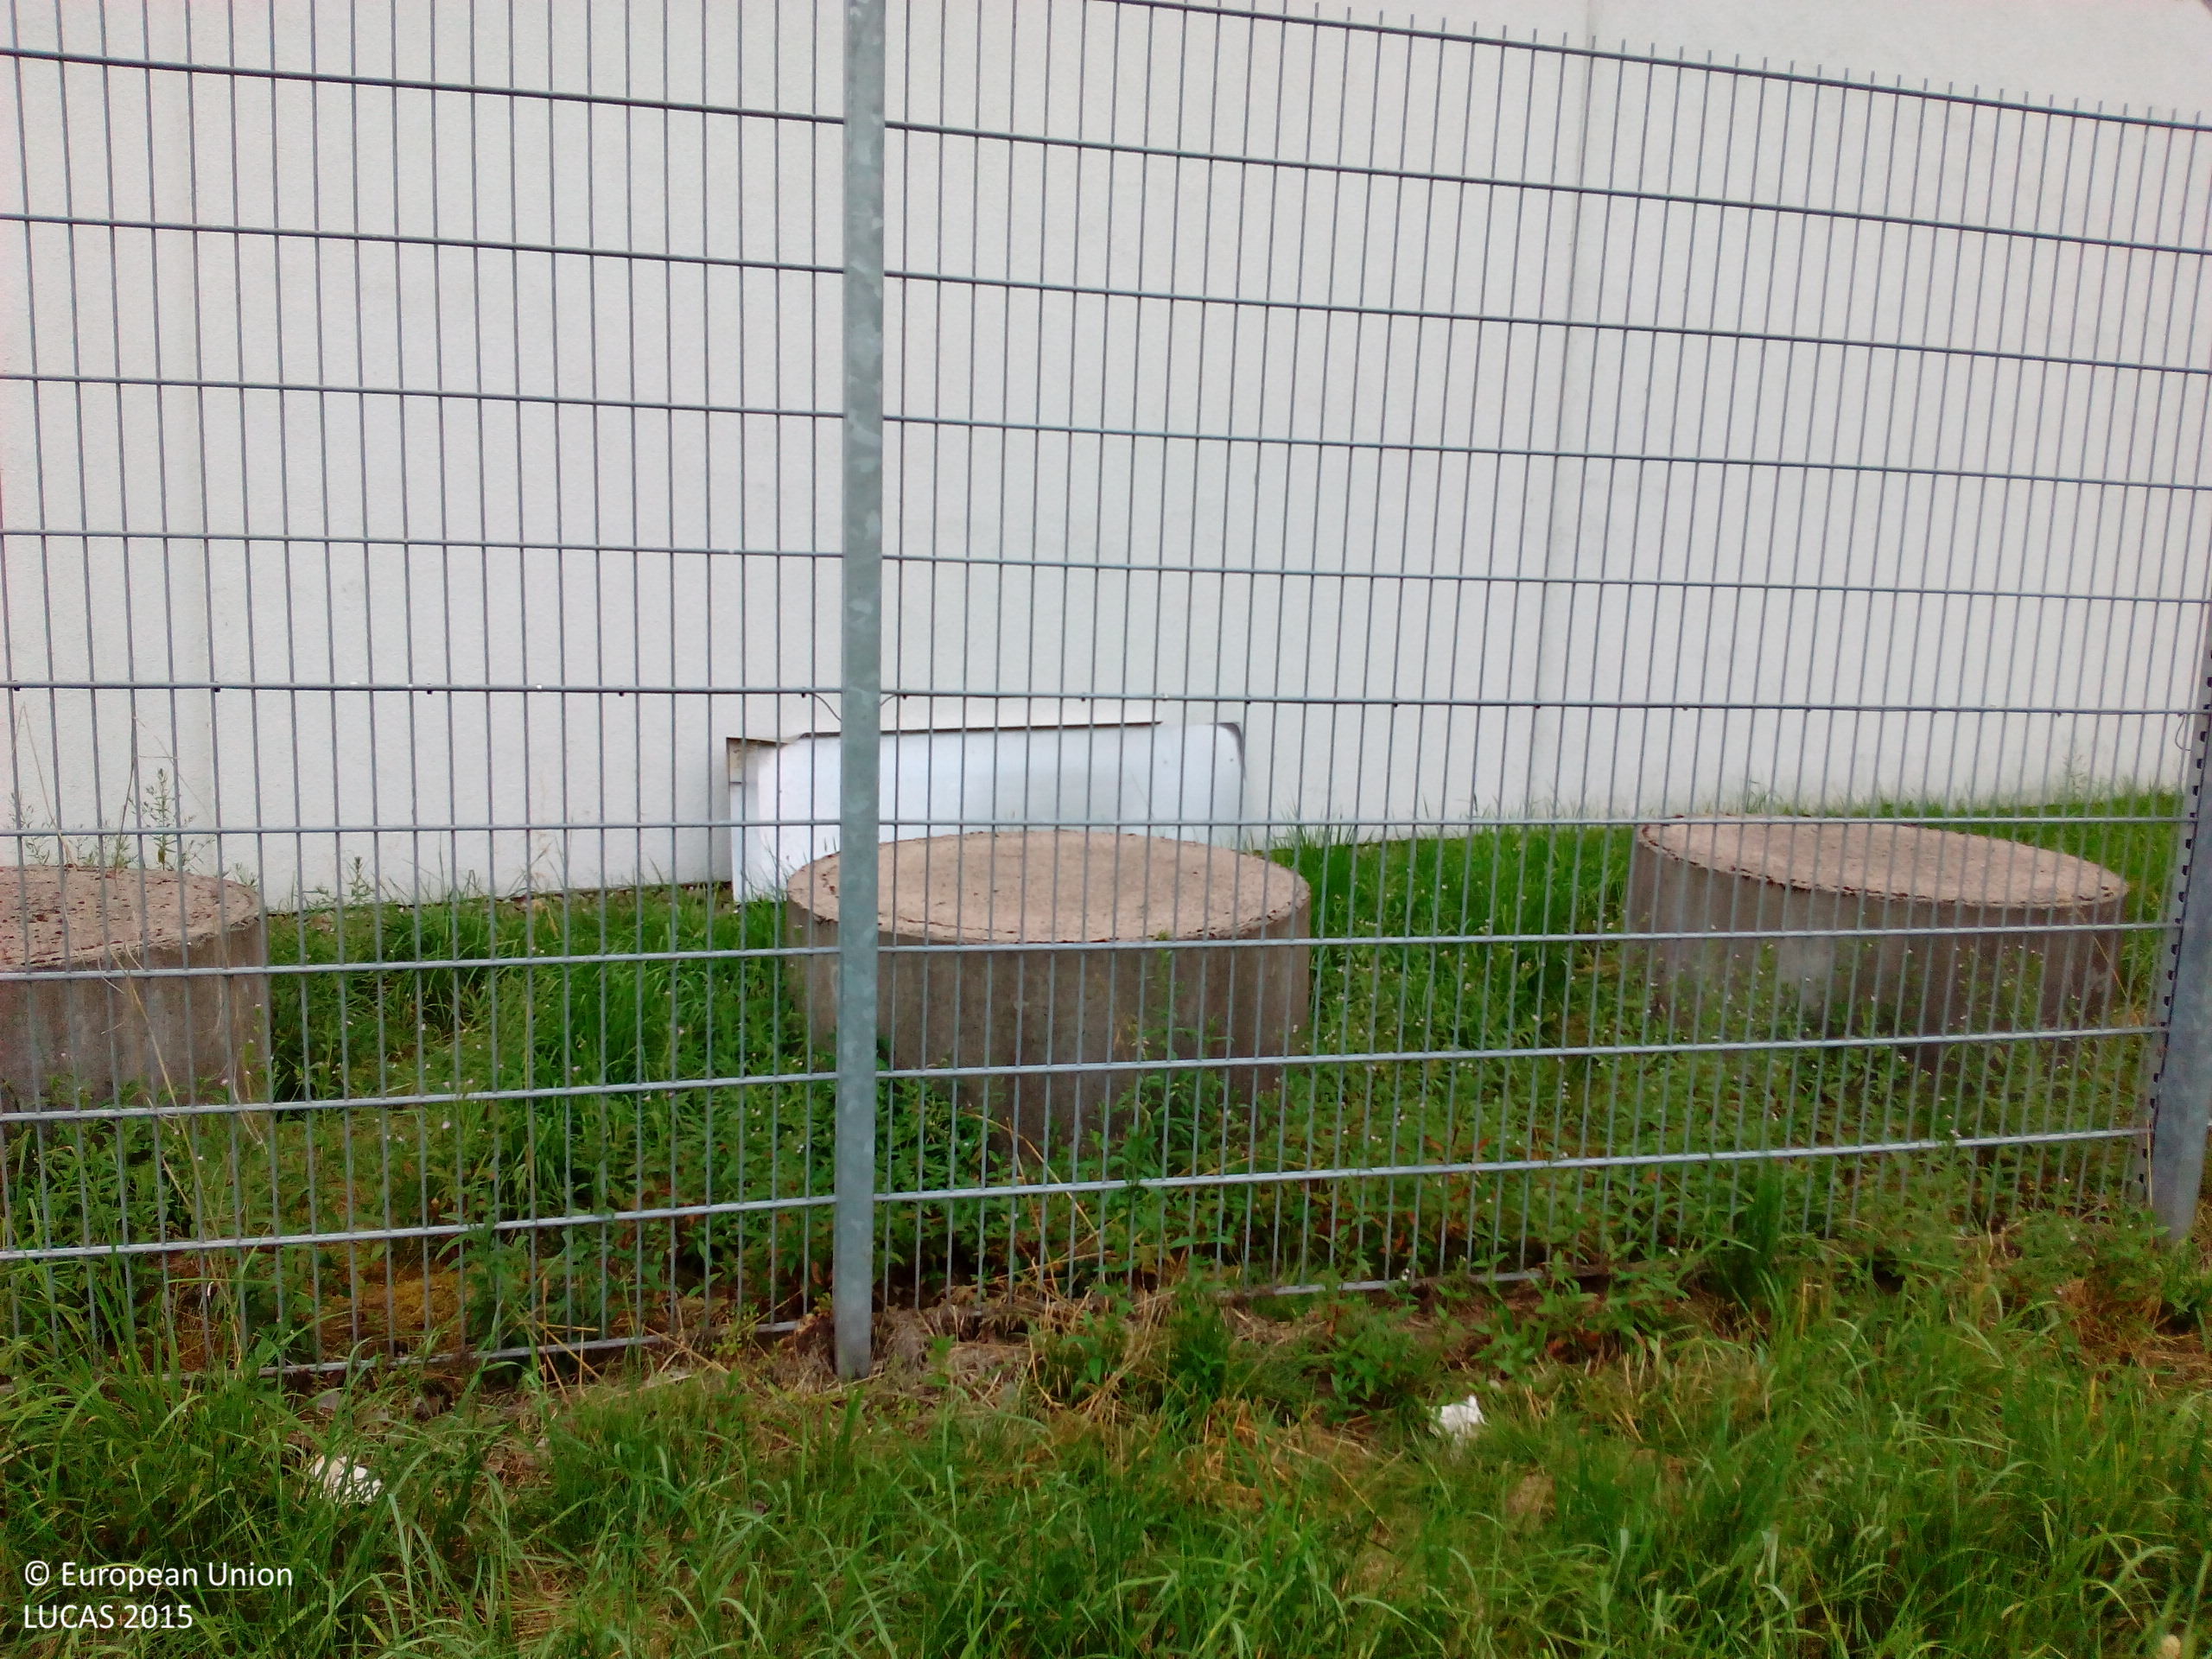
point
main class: Grassland
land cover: Grassland without tree/shrub cover
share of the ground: > 75 %
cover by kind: herbaceous plants 100 %
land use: Logistics and storage
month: July
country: DE
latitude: 47.9616
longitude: 8.5144
